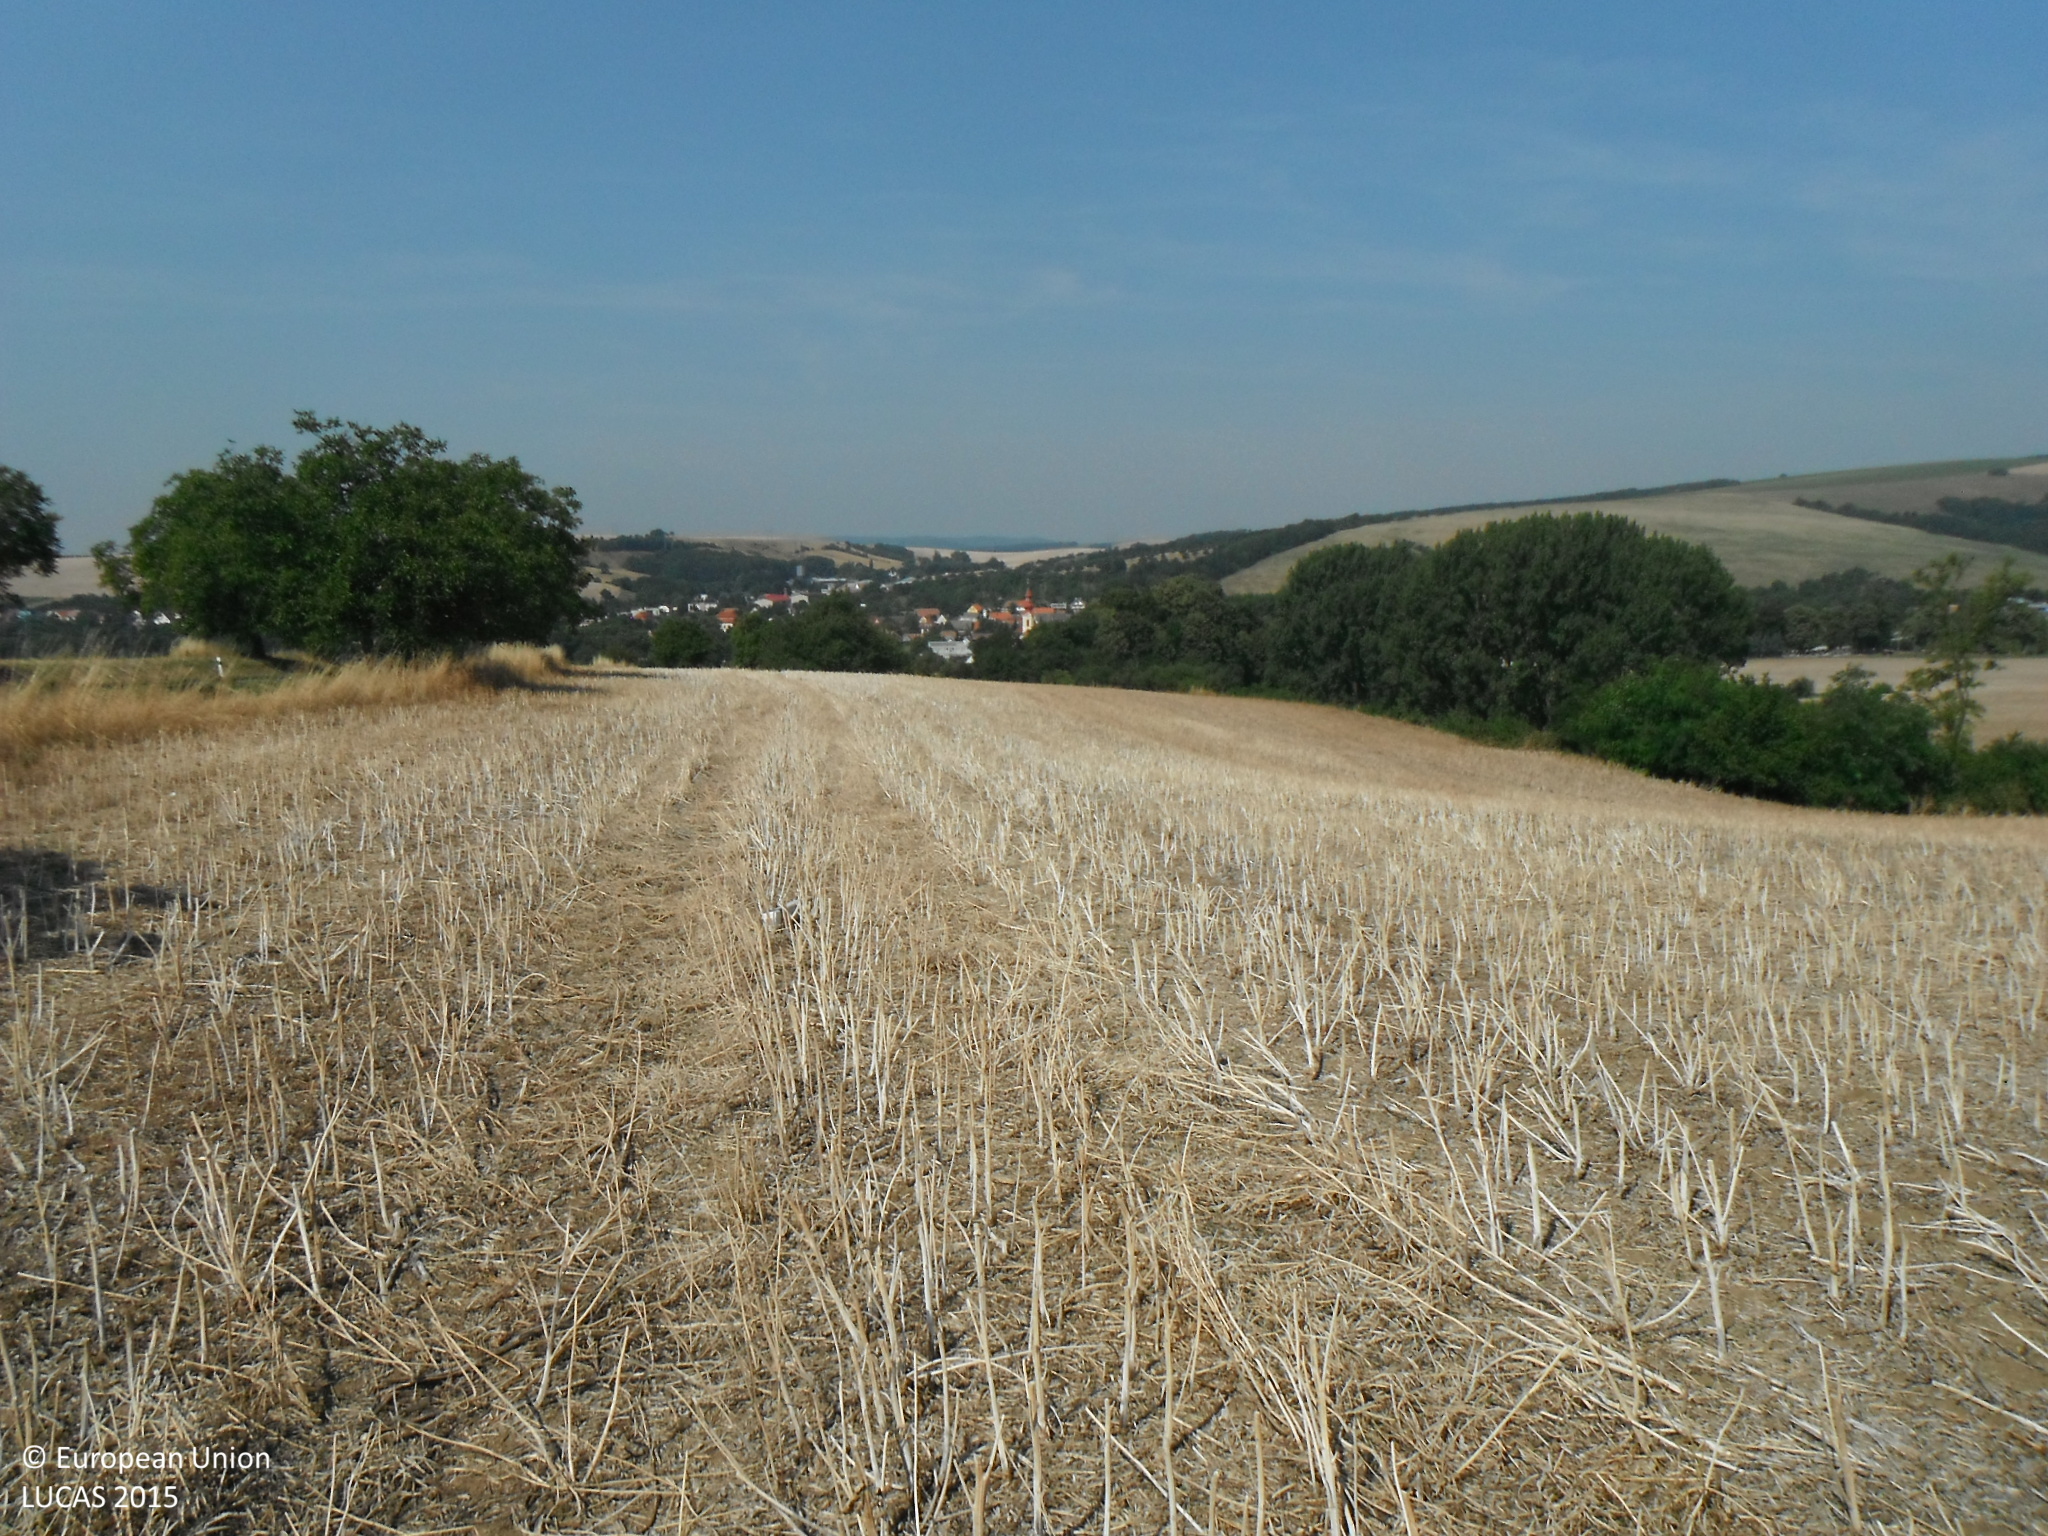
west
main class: Cropland
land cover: Rape and turnip rape
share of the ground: < 10 %
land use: Agriculture (excluding fallow land and kitchen gardens)
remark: Harvested field
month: August
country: SK
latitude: 48.7321
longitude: 17.4204
